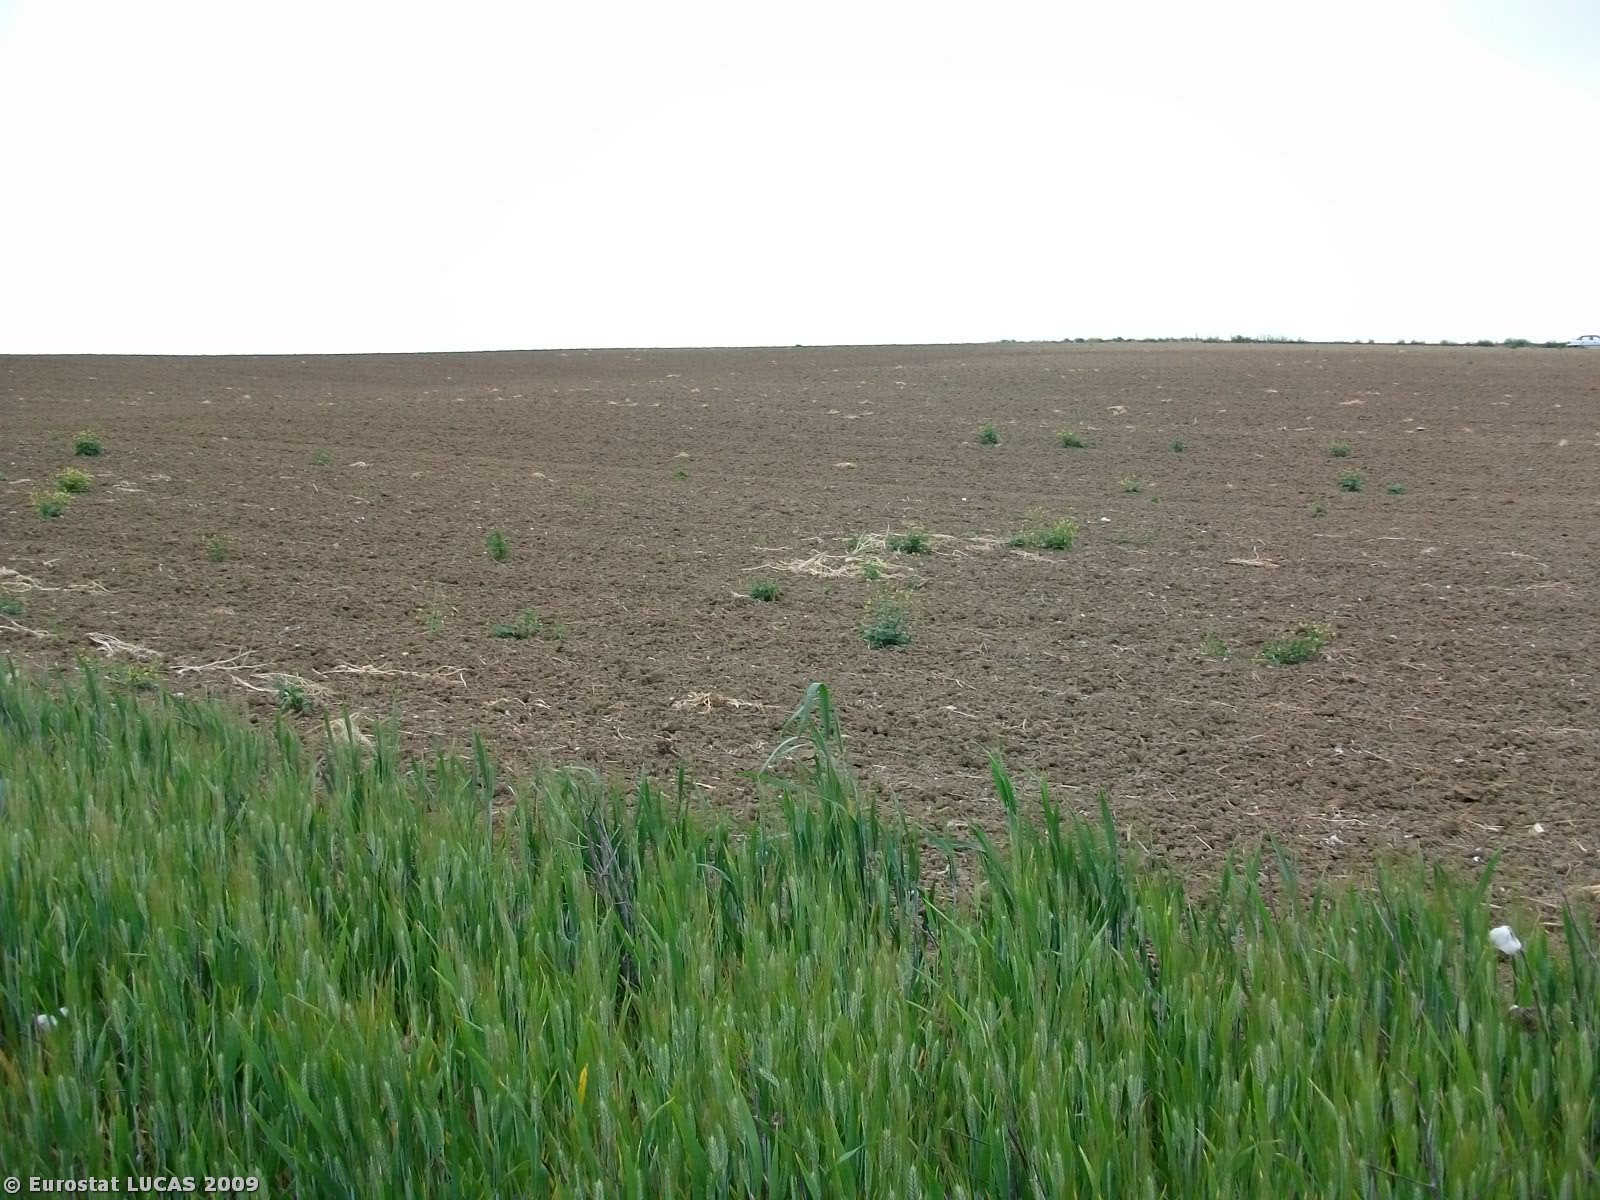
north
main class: Cropland
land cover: Durum wheat
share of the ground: > 75 %
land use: Agriculture (excluding fallow land and kitchen gardens)
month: April
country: GR
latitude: 39.3745
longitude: 22.4891
